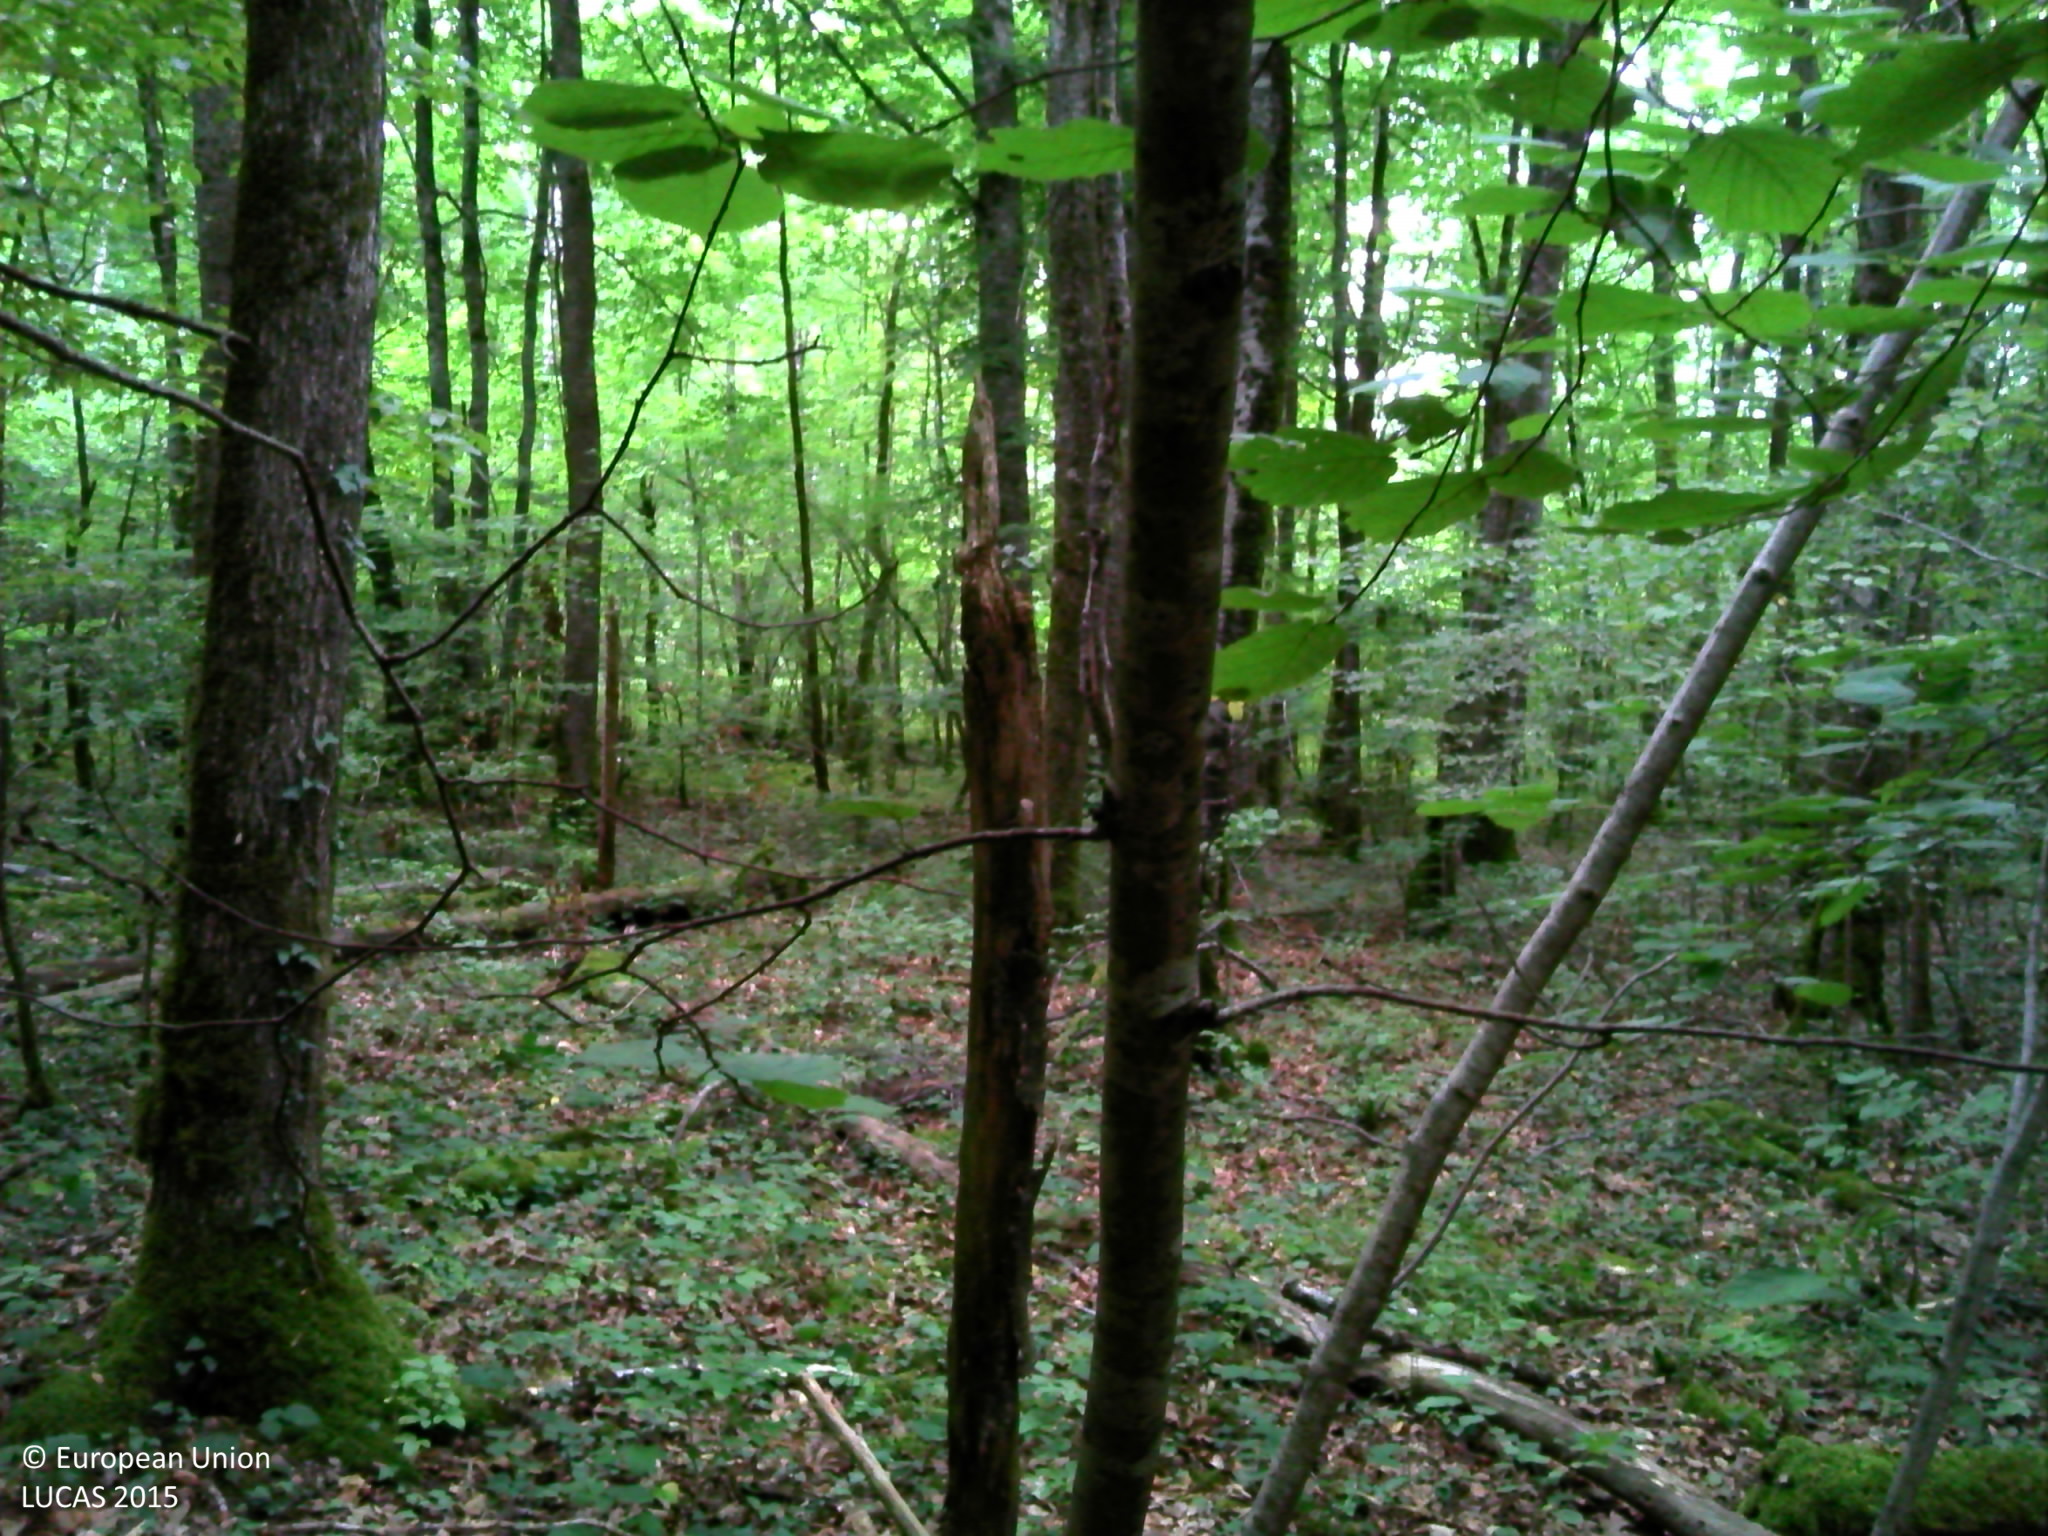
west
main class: Woodland
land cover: Broadleaved woodland
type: mesophytic deciduous forest
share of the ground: > 75 %
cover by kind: broadleaved forest trees 85 %, shrubs 5 %, herbaceous plants 5 %, lichens and mosses 5 %
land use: Forestry
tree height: > 5 m
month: August
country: FR
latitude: 47.8757
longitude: 4.2617
